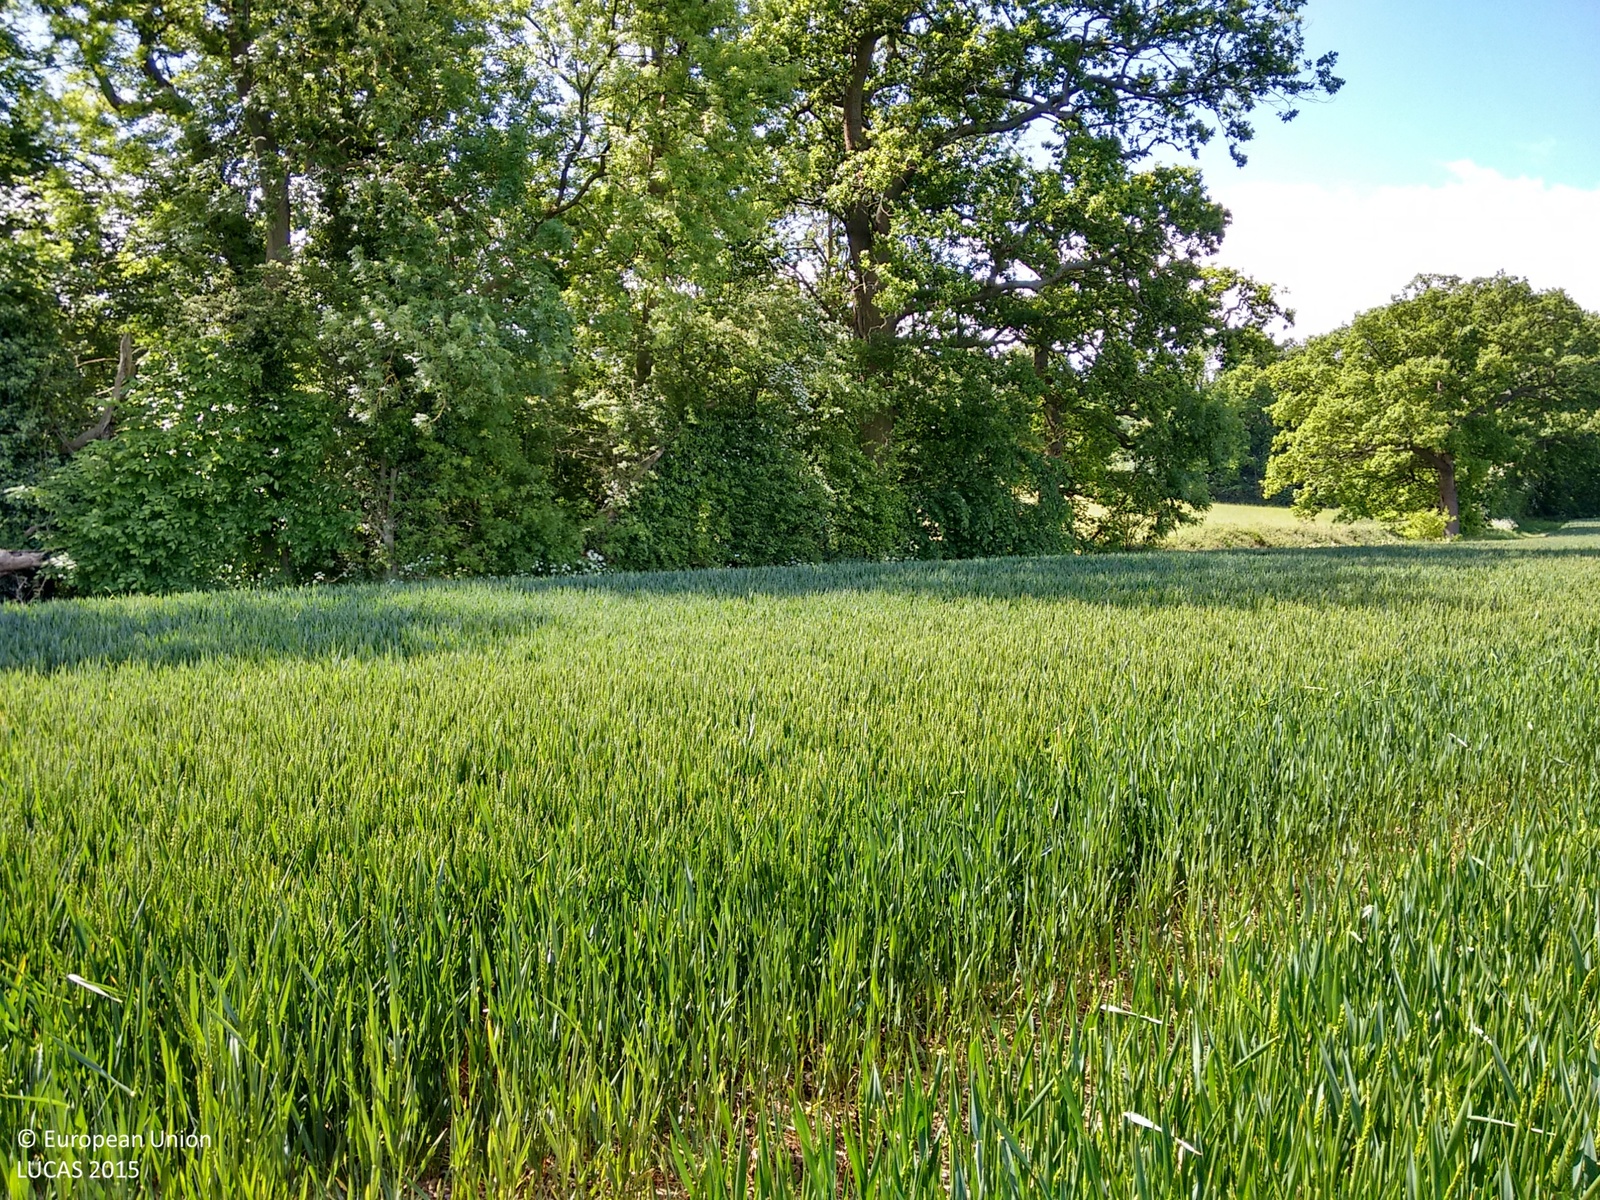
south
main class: Cropland
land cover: Common wheat
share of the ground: > 75 %
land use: Agriculture (excluding fallow land and kitchen gardens)
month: June
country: GB
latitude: 51.6779
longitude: -0.2603
